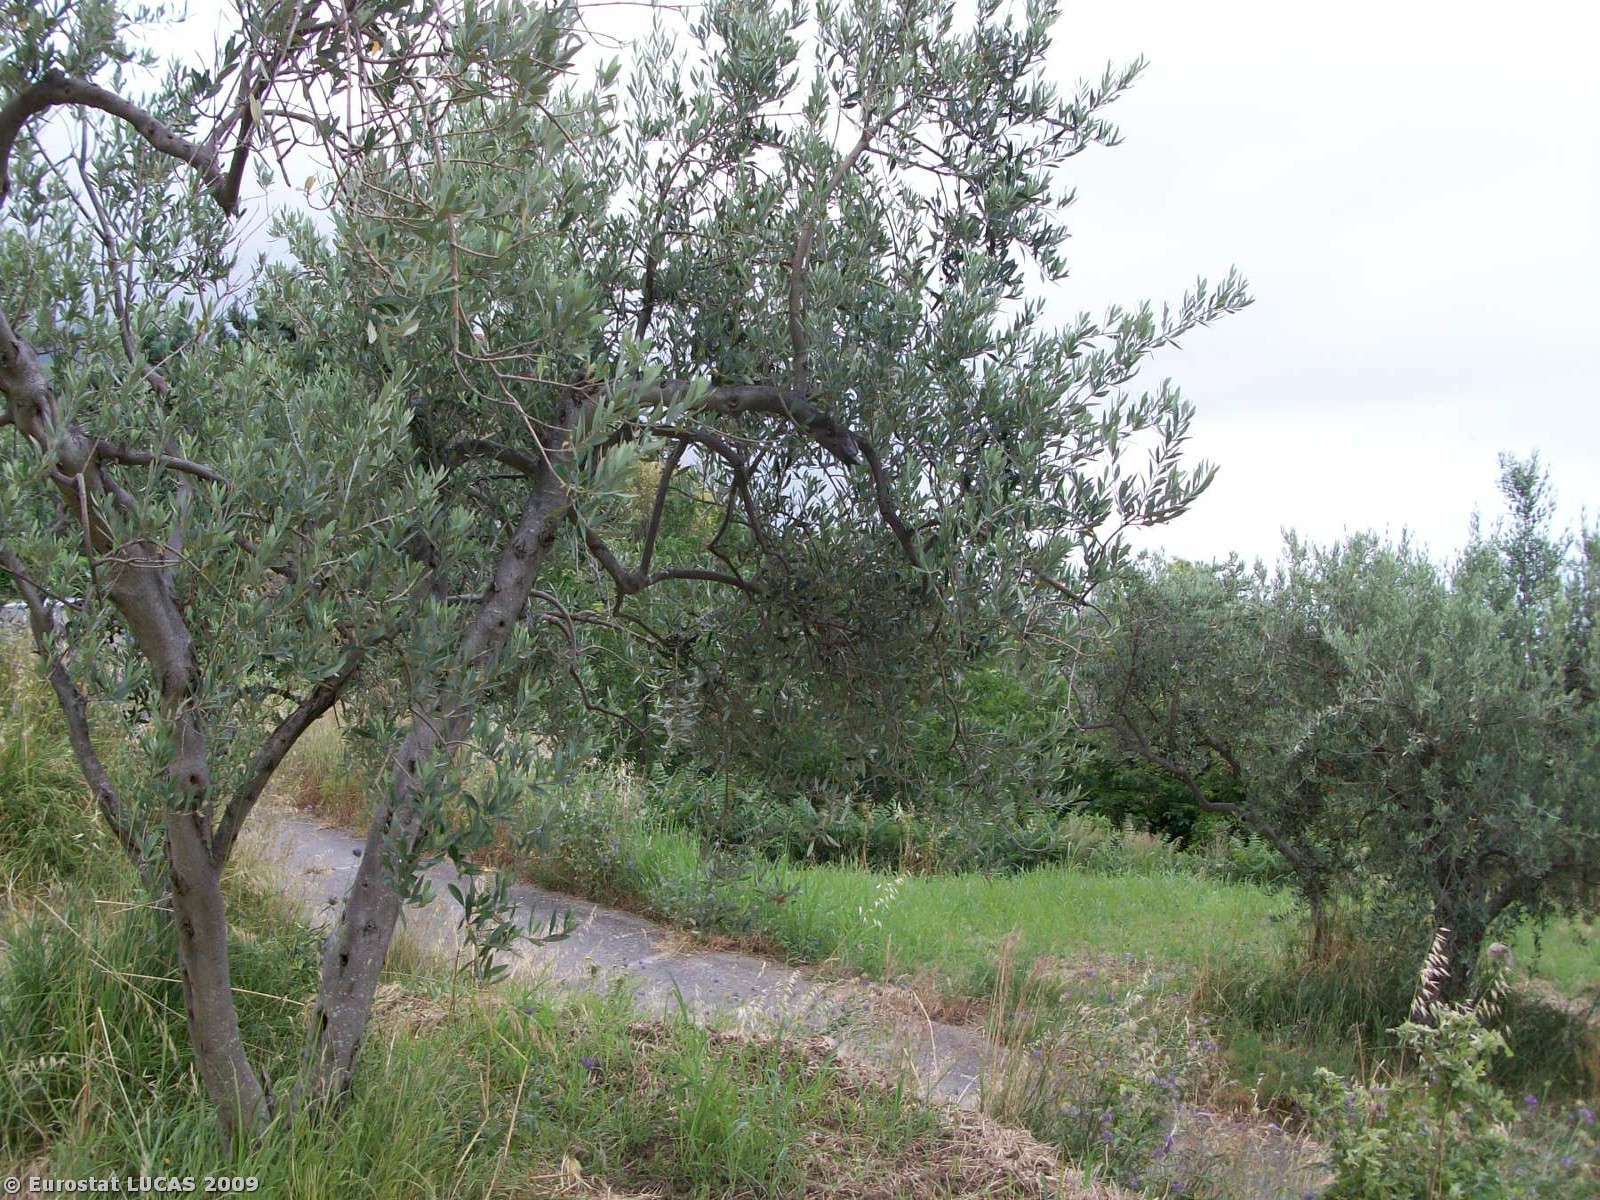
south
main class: Cropland
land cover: Olive groves
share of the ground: 10 - 25 %
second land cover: Spontaneously vegetated surfaces
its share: > 75 %
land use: Agriculture (excluding fallow land and kitchen gardens)
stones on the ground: < 10 %
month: June
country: IT
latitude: 39.3731
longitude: 16.0412
